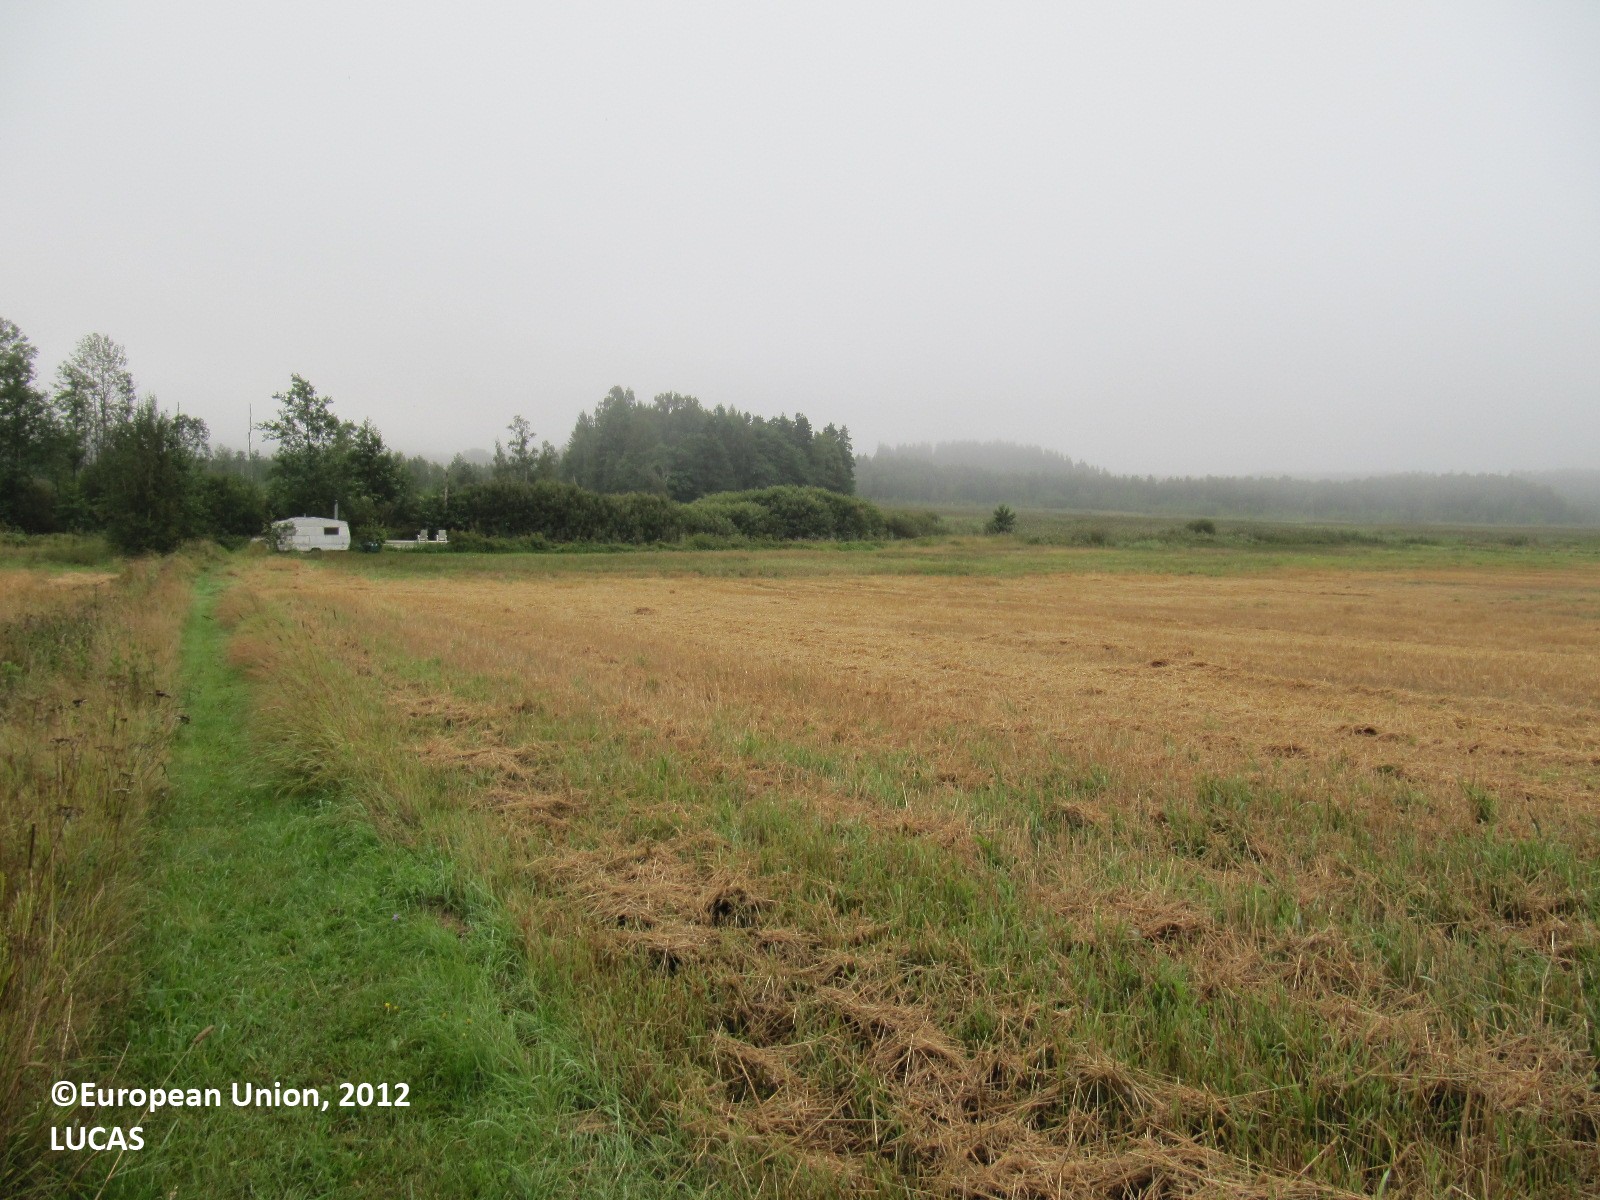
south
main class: Grassland
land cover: Spontaneously vegetated surfaces
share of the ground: > 75 %
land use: Agriculture (excluding fallow land and kitchen gardens)
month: August
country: FI
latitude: 60.1986
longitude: 24.3005
